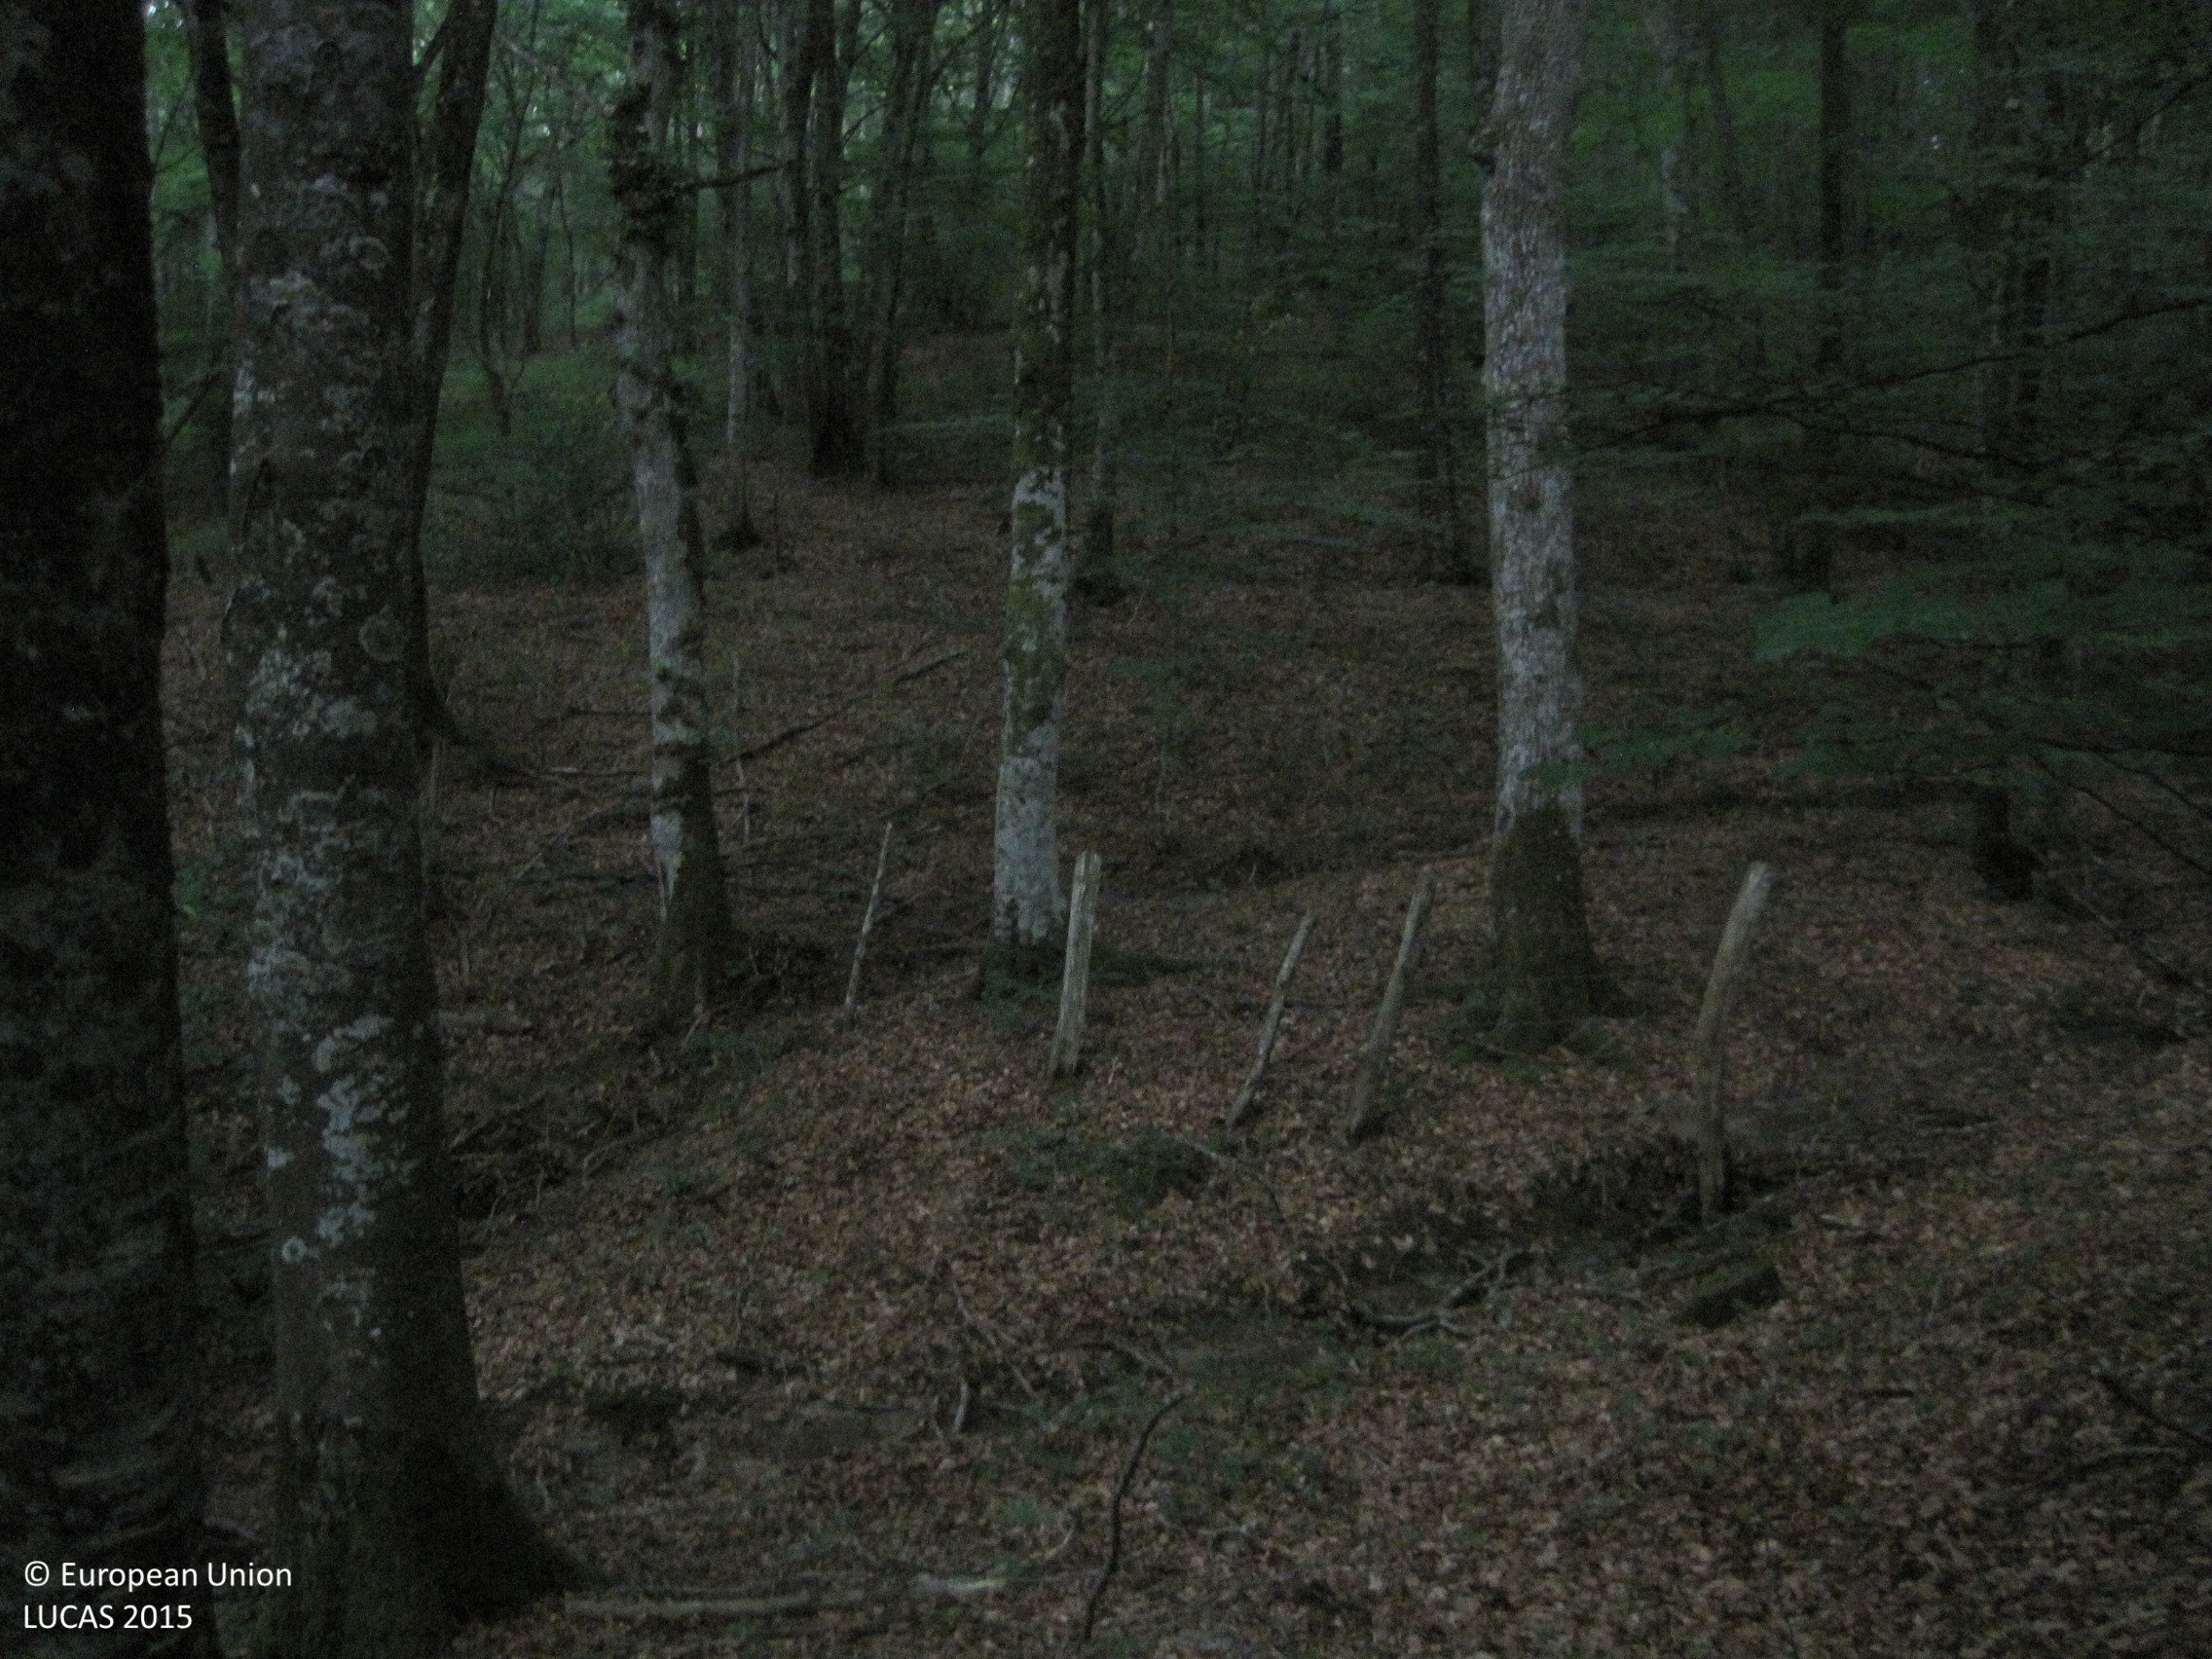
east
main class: Woodland
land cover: Broadleaved woodland
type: beech forest
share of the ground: > 75 %
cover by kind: broadleaved forest trees 100 %
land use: Forestry
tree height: > 5 m
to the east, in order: Broadleaved woodland; Fences; Broadleaved woodland; Tracks; Broadleaved woodland; Tracks; Broadleaved woodland
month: June
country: ES
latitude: 42.9372
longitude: -1.7193
